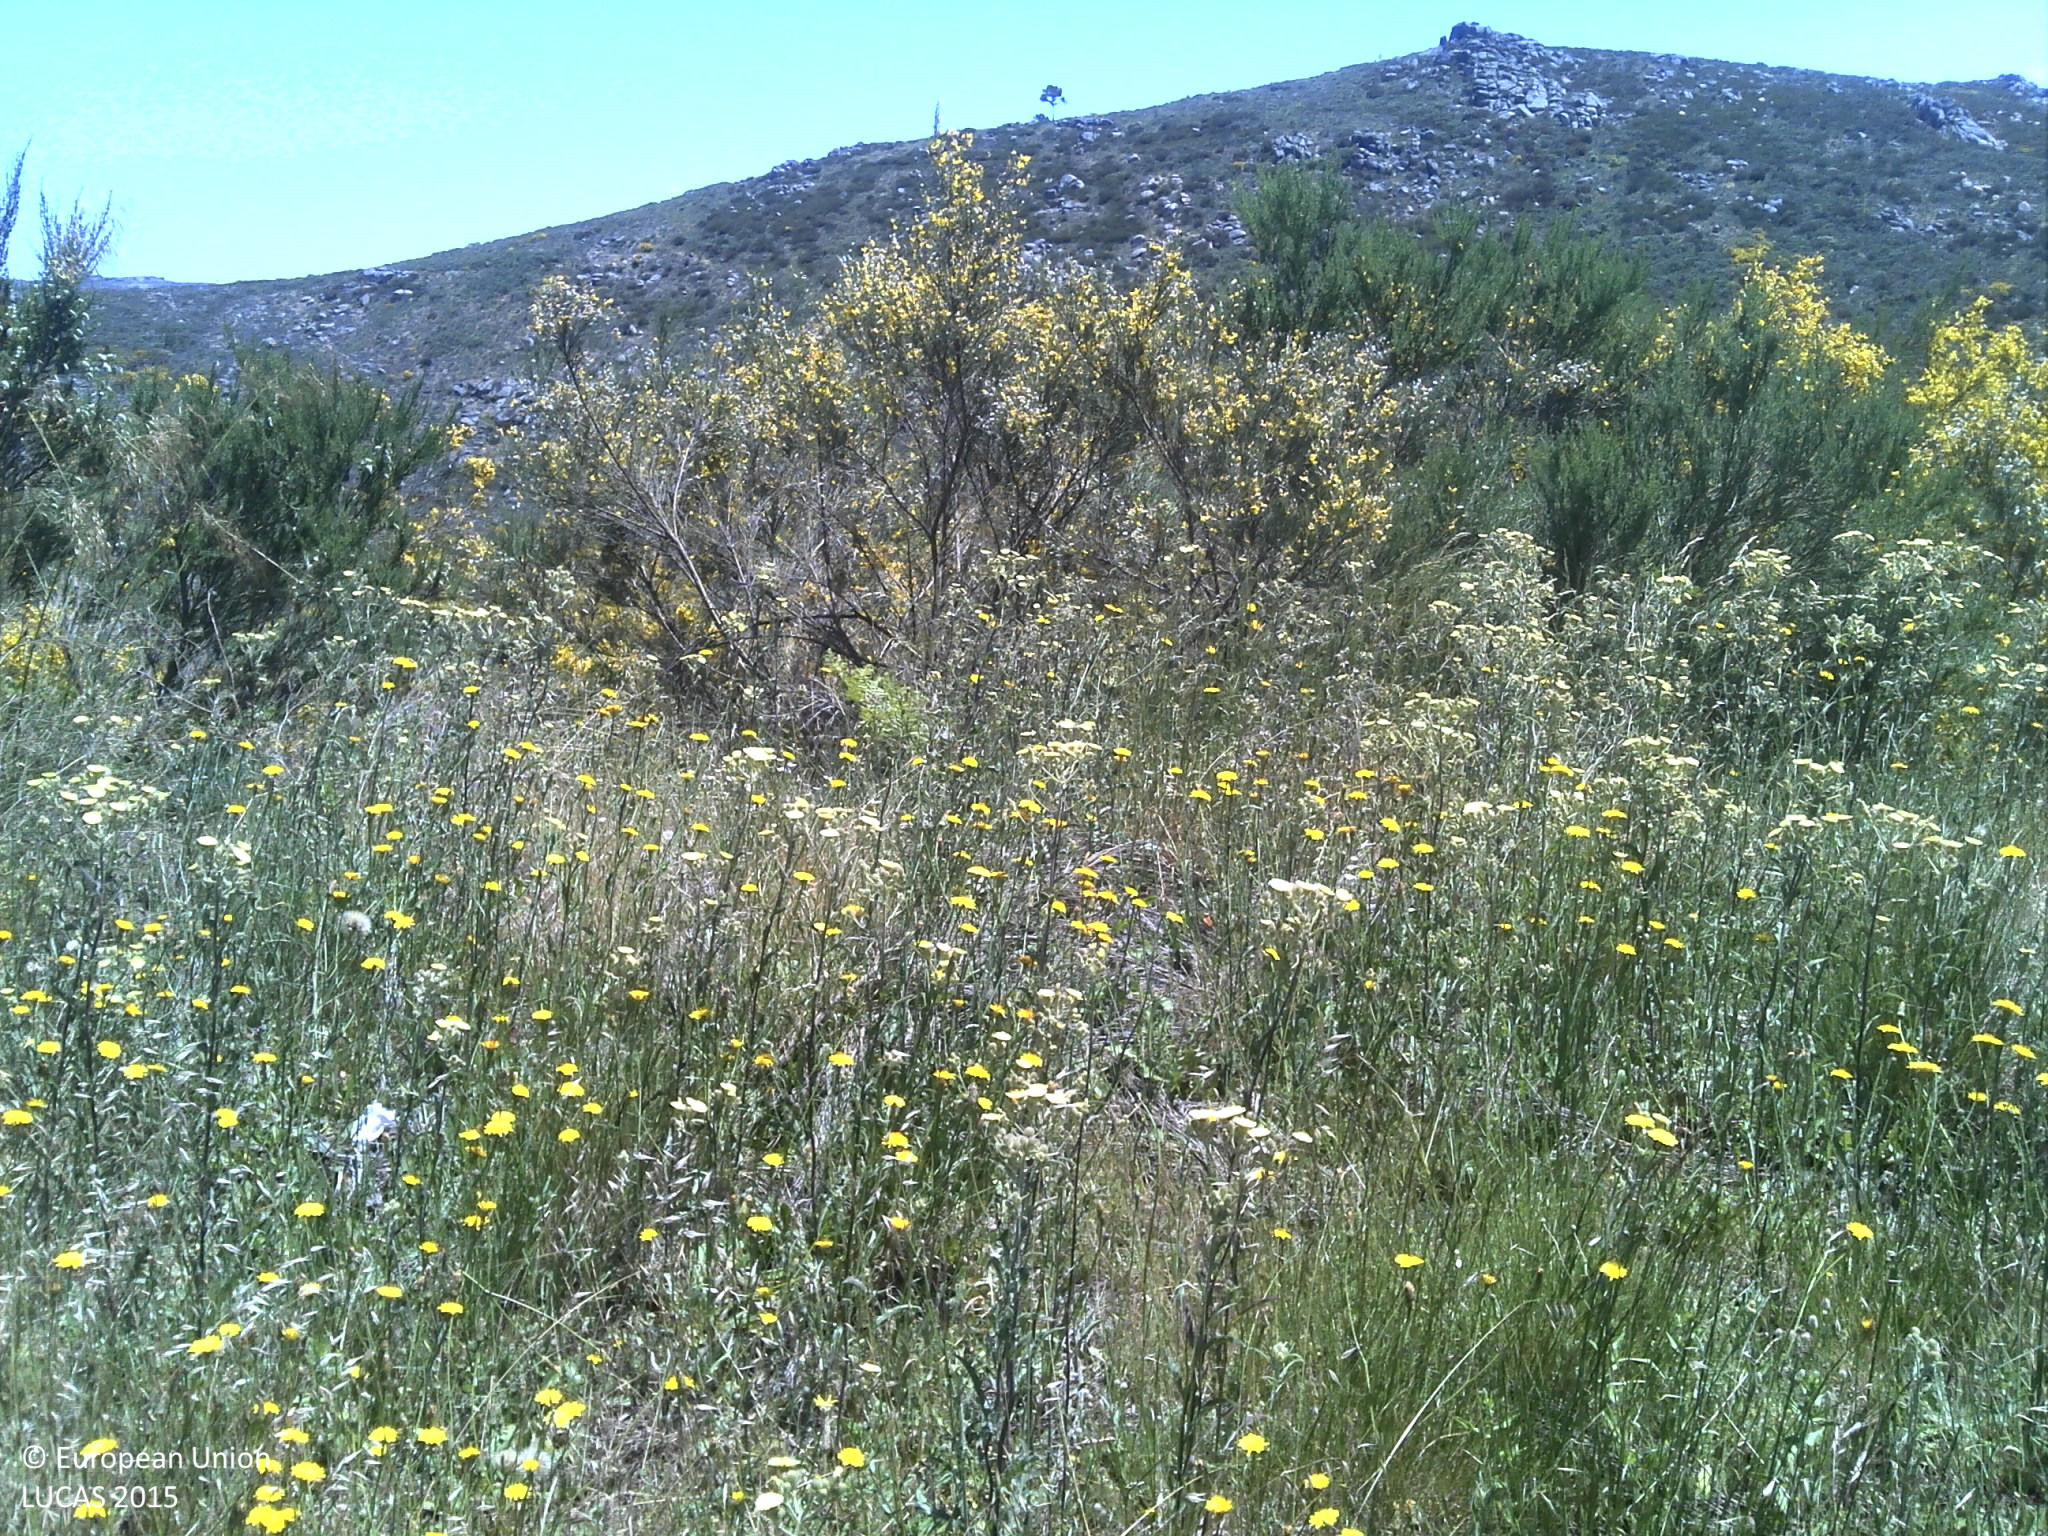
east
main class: Shrubland
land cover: Shrubland without tree cover
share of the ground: 50 - 75 %
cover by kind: shrubs 75 %, unconsolidated bare surface 20 %, herbaceous plants 5 %
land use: Semi-natural and natural areas not in use
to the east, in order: Shrubland without tree cover; Rocks and stones; Shrubland without tree cover; Grass margins; Paved roads, cycling and walking lanes; Grass margins; Shrubland without tree cover; Rivers and streams; Shrubland without tree cover; Tracks; Grassland without tree/shrub cover; Dry stone walls; Fences; Grassland without tree/shrub cover
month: May
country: PT
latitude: 40.4634
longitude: -7.3364
